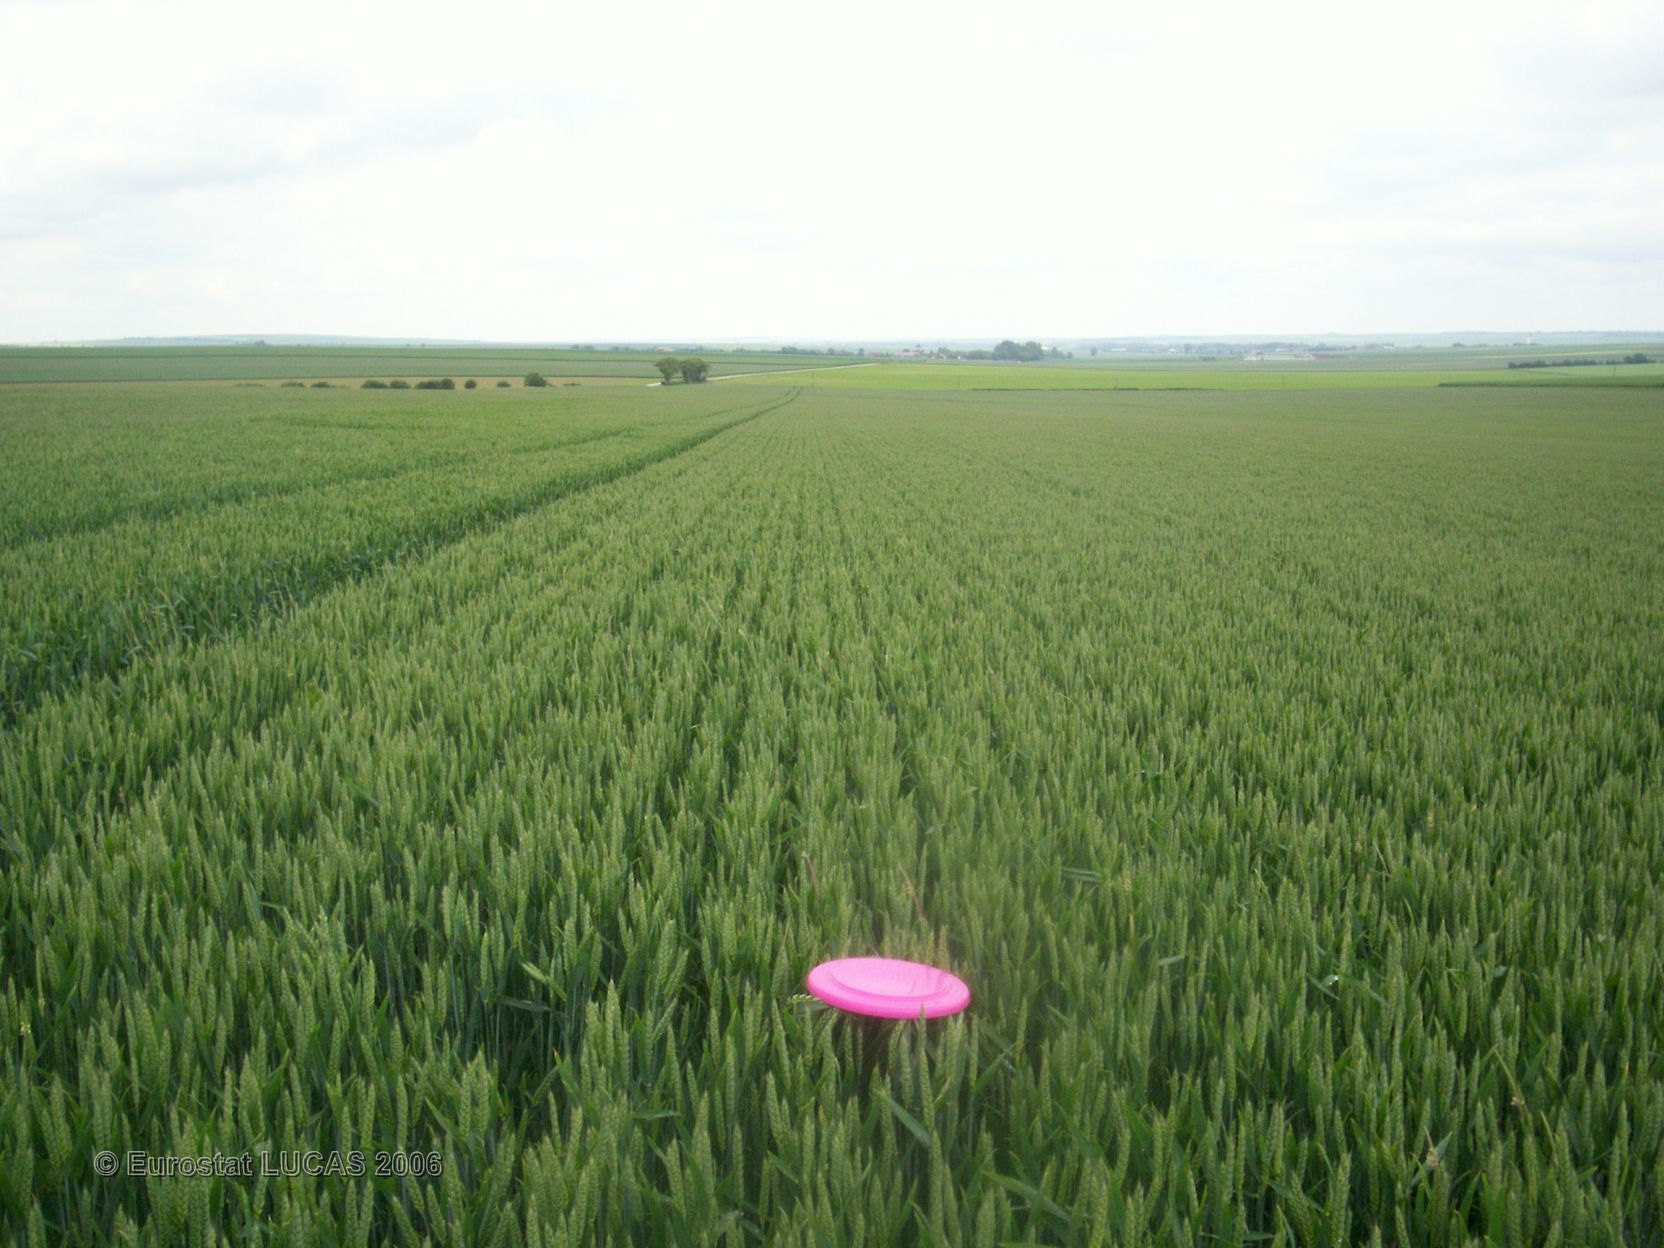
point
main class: Cropland
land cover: Common wheat
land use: Agriculture (excluding fallow land and kitchen gardens)
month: June
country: FR
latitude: 48.5889
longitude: 4.4520
